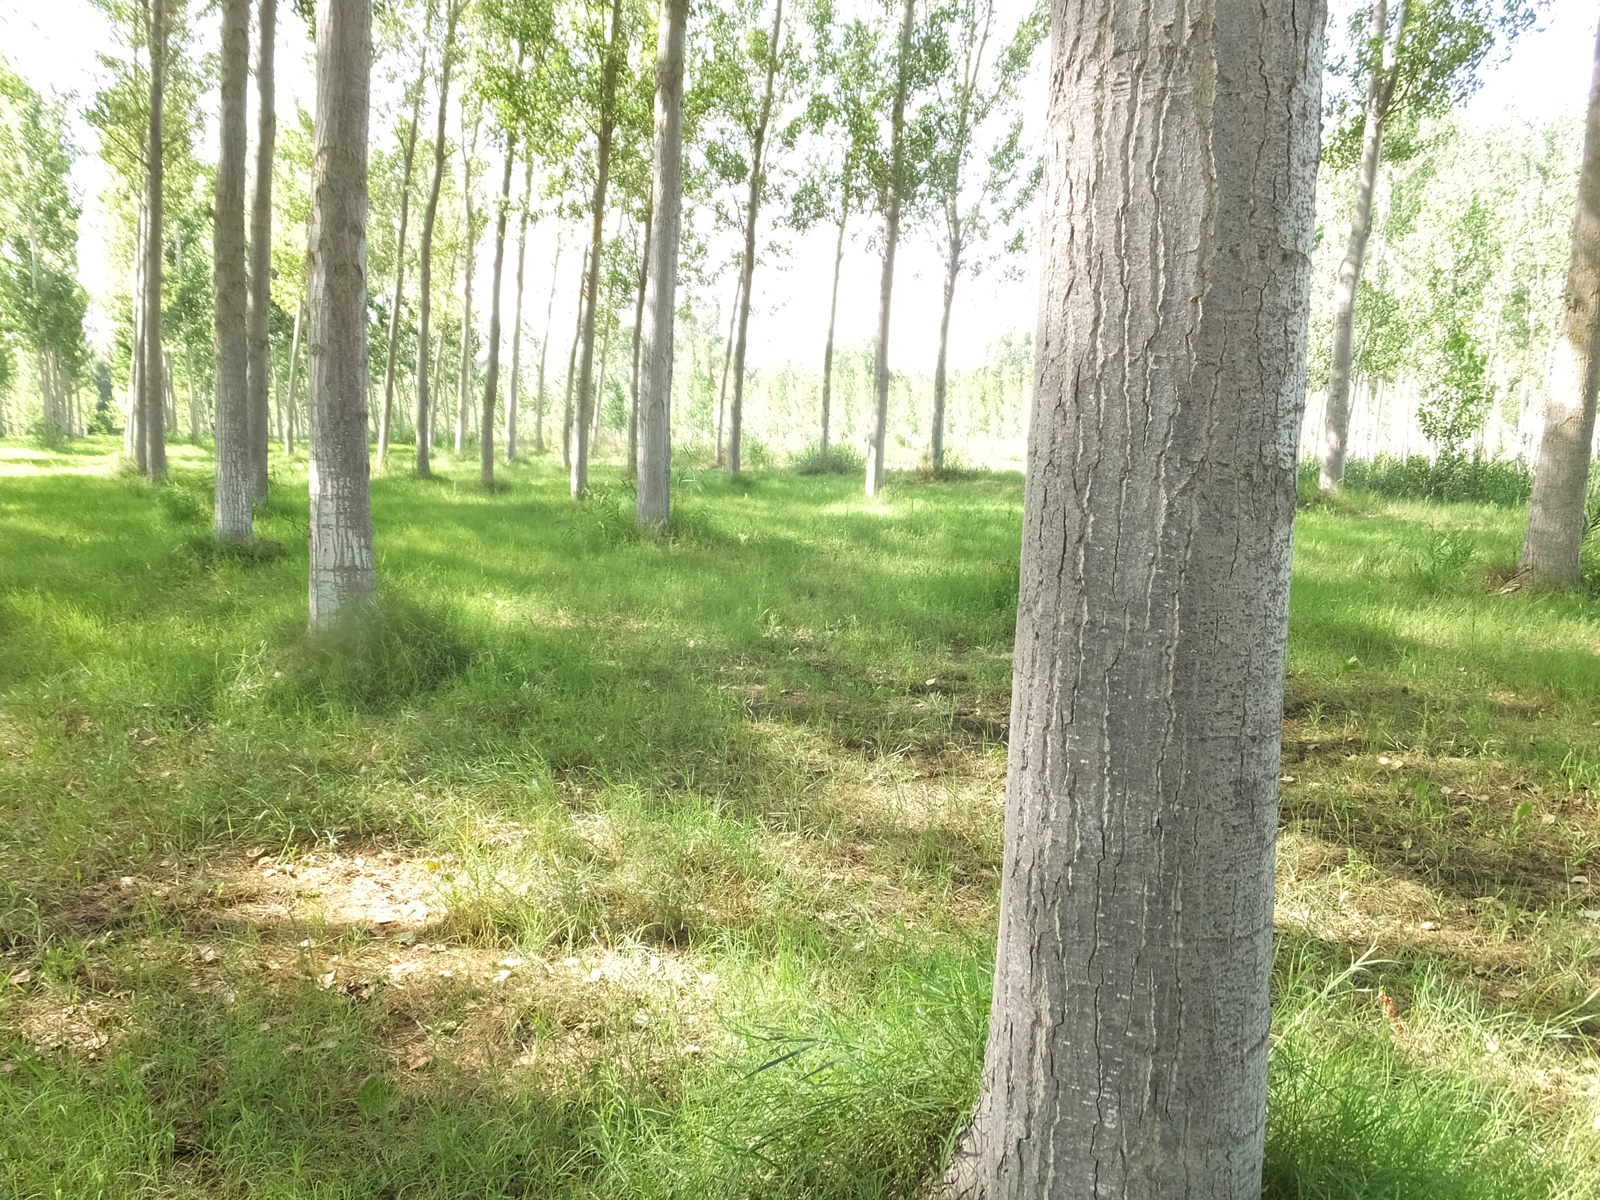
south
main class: Woodland
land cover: Broadleaved woodland
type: broadleaved evergreen forest
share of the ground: > 75 %
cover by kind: broadleaved forest trees 95 %, herbaceous plants 5 %
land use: Forestry
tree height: > 5 m
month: July
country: ES
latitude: 41.4741
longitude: 0.4441
